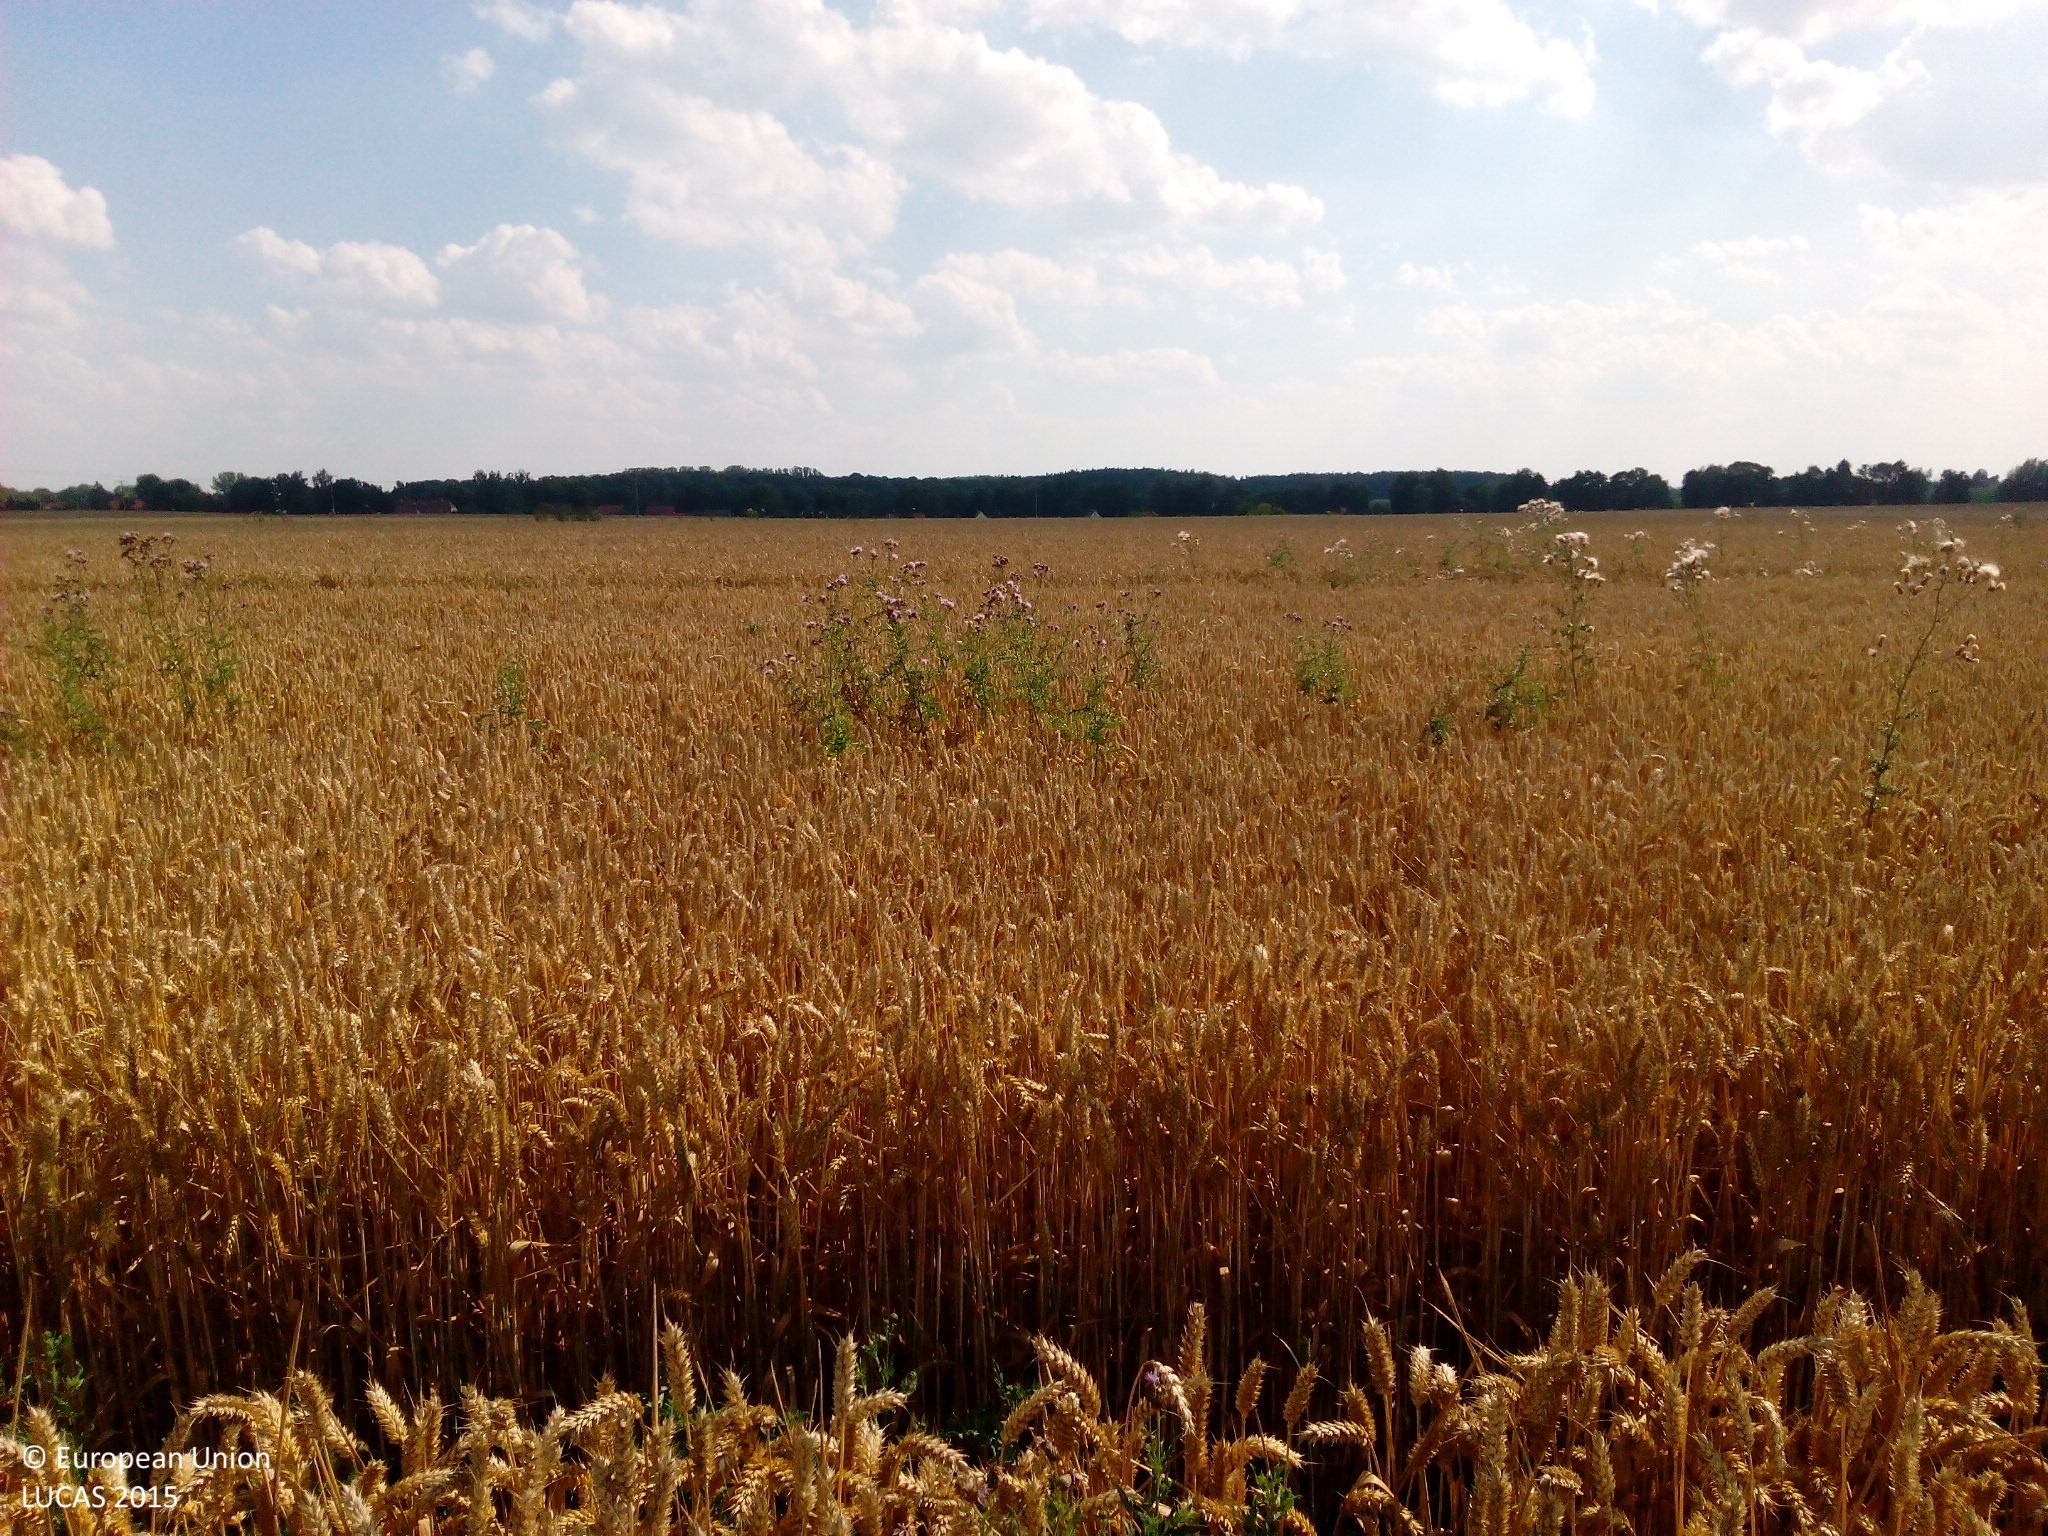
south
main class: Cropland
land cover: Common wheat
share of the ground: > 75 %
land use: Agriculture (excluding fallow land and kitchen gardens)
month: August
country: DE
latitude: 53.5821
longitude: 13.6099
